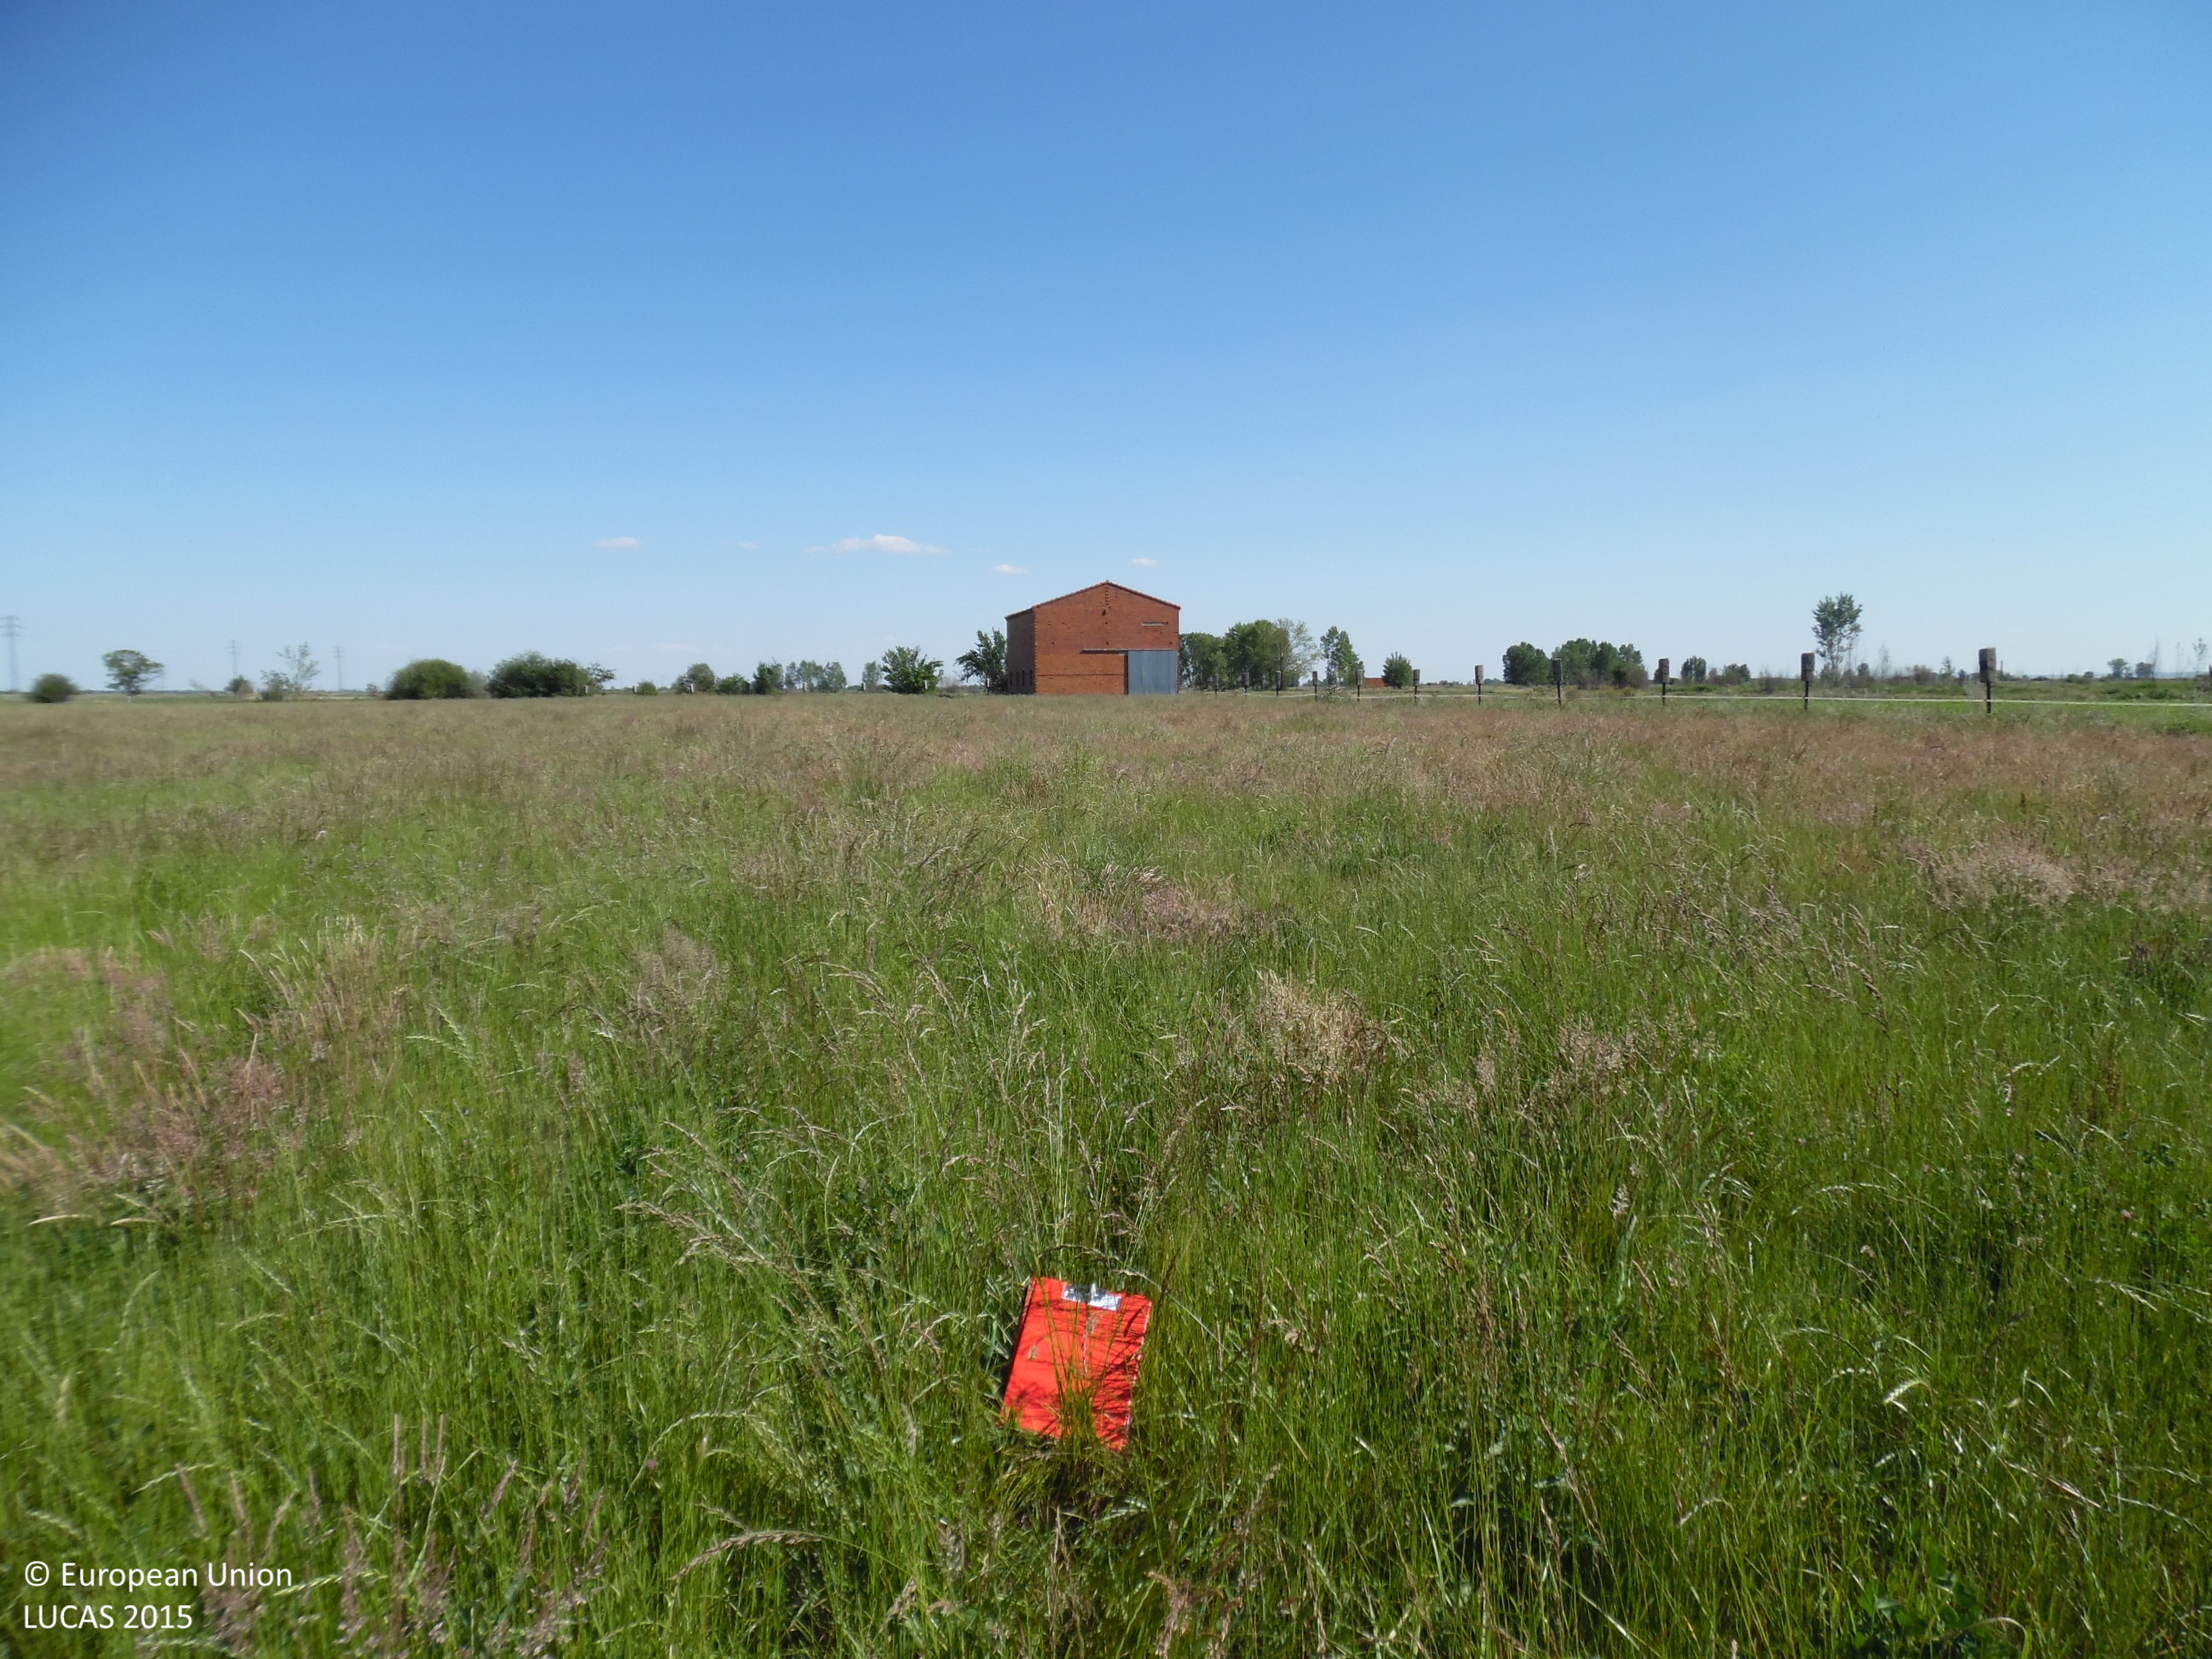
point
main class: Cropland
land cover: Other leguminous and mixtures for fodder
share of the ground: > 75 %
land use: Agriculture (excluding fallow land and kitchen gardens)
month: June
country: ES
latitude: 42.4381
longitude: -5.7691
